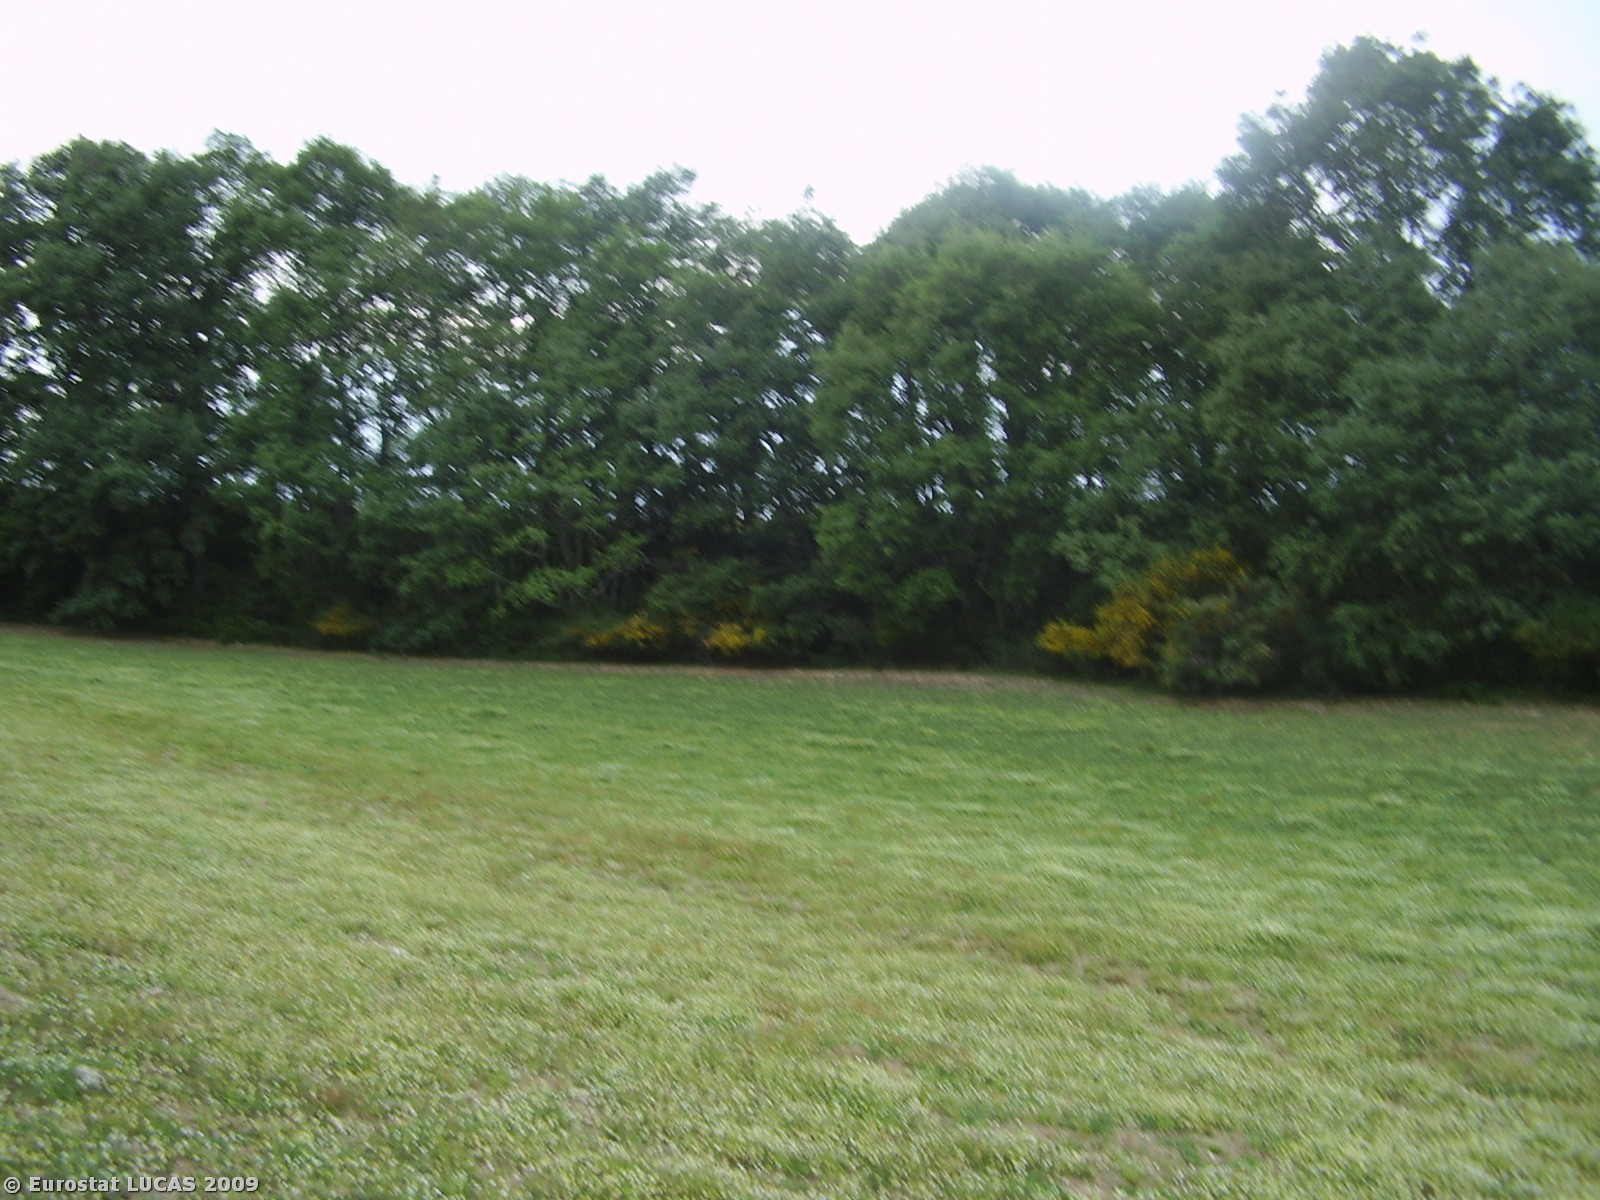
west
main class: Grassland
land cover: Grassland without tree/shrub cover
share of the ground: > 75 %
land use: Forestry
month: June
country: PT
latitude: 41.6595
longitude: -6.8170
